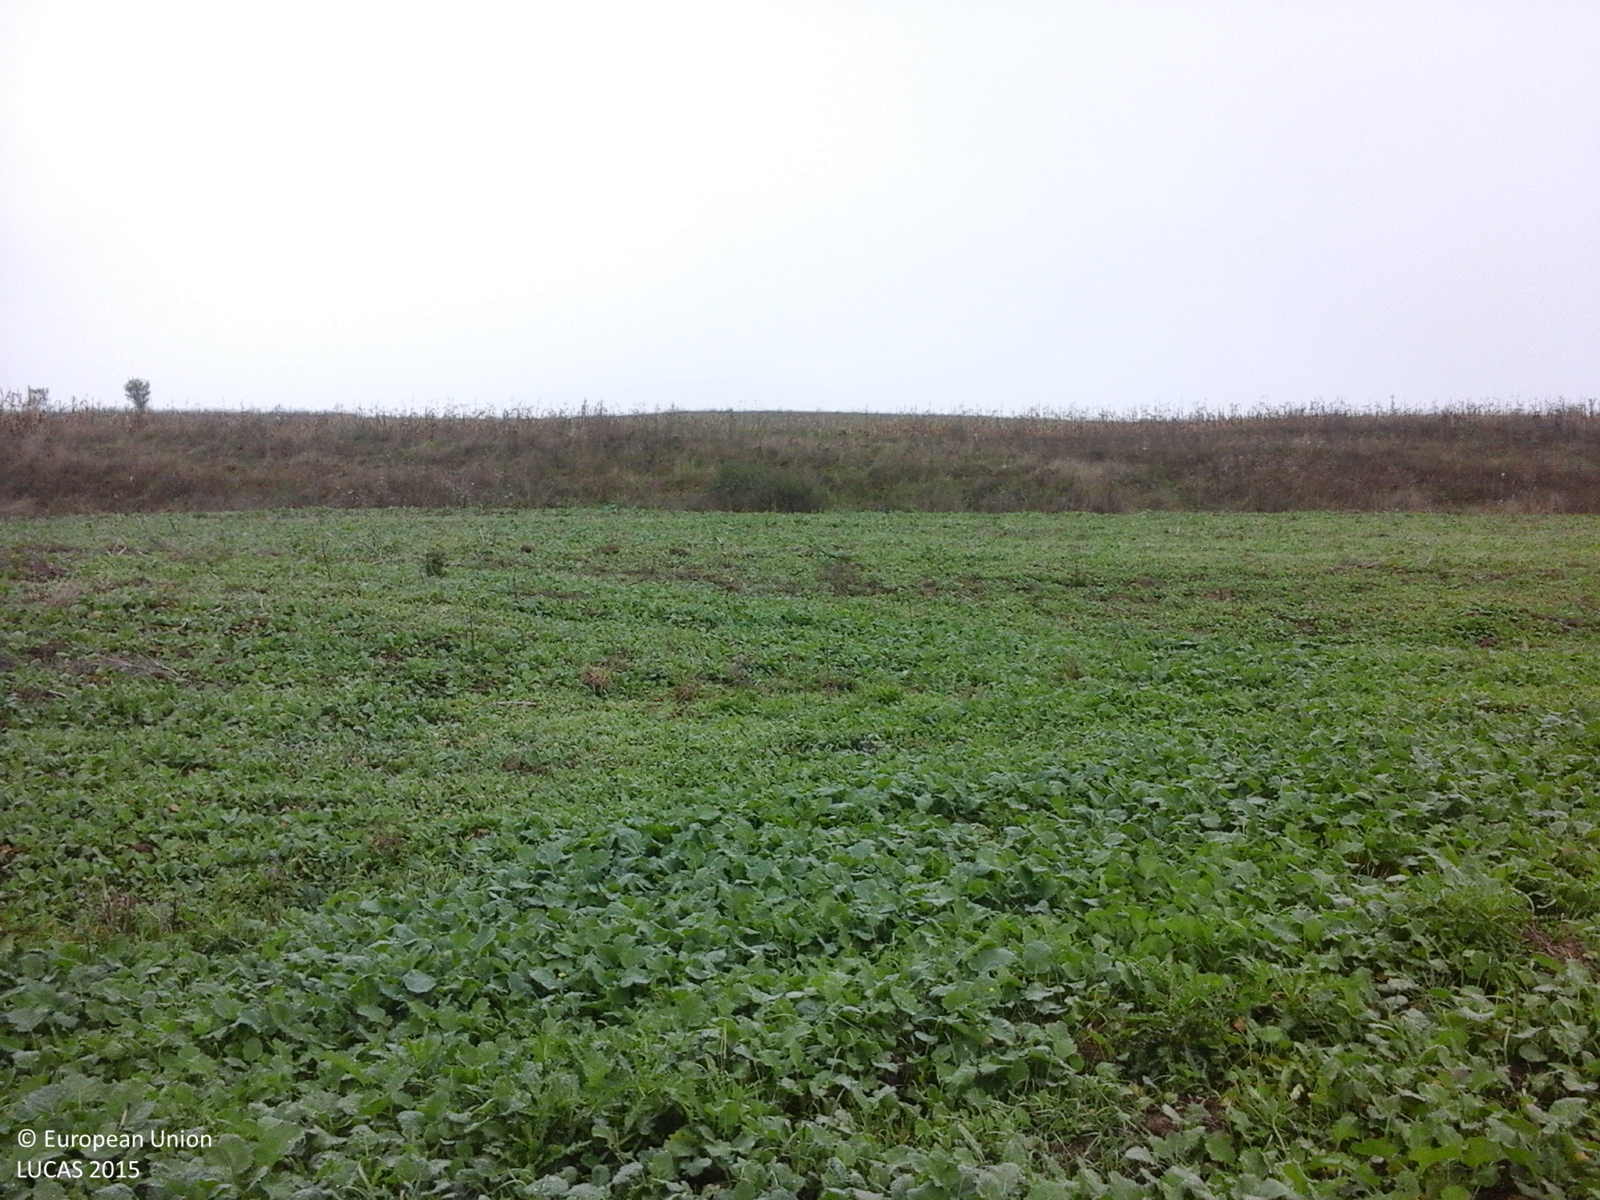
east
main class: Cropland
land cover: Rape and turnip rape
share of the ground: > 75 %
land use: Agriculture (excluding fallow land and kitchen gardens)
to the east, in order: Rape and turnip rape; Maize; Spontaneously vegetated surfaces; Sunflower; Grass margins; Ditches and canals; Grass margins; Tracks; Other bare soil; Lucerne
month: October
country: RO
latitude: 46.3938
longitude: 24.2698
